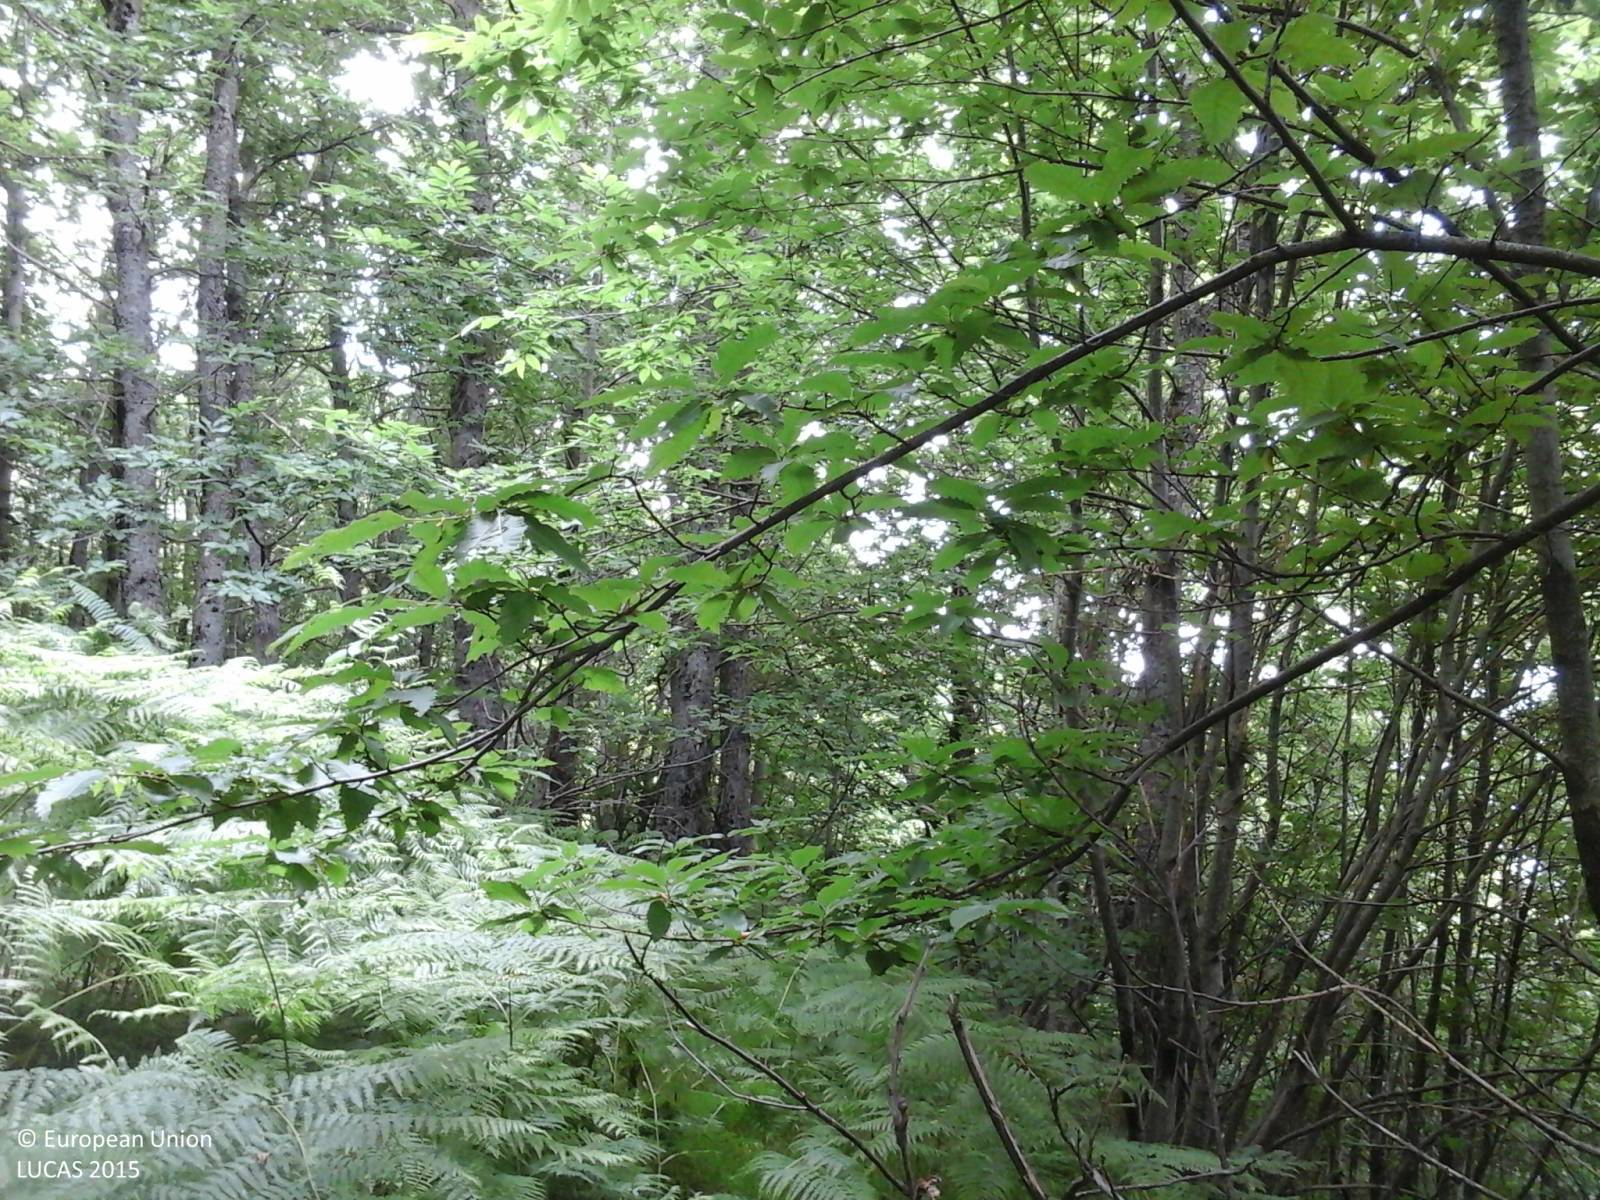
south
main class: Woodland
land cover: Broadleaved woodland
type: thermophilous deciduous forest
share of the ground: > 75 %
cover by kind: broadleaved forest trees 100 %
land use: Forestry
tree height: > 5 m
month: June
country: IT
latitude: 44.2599
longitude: 10.3124
